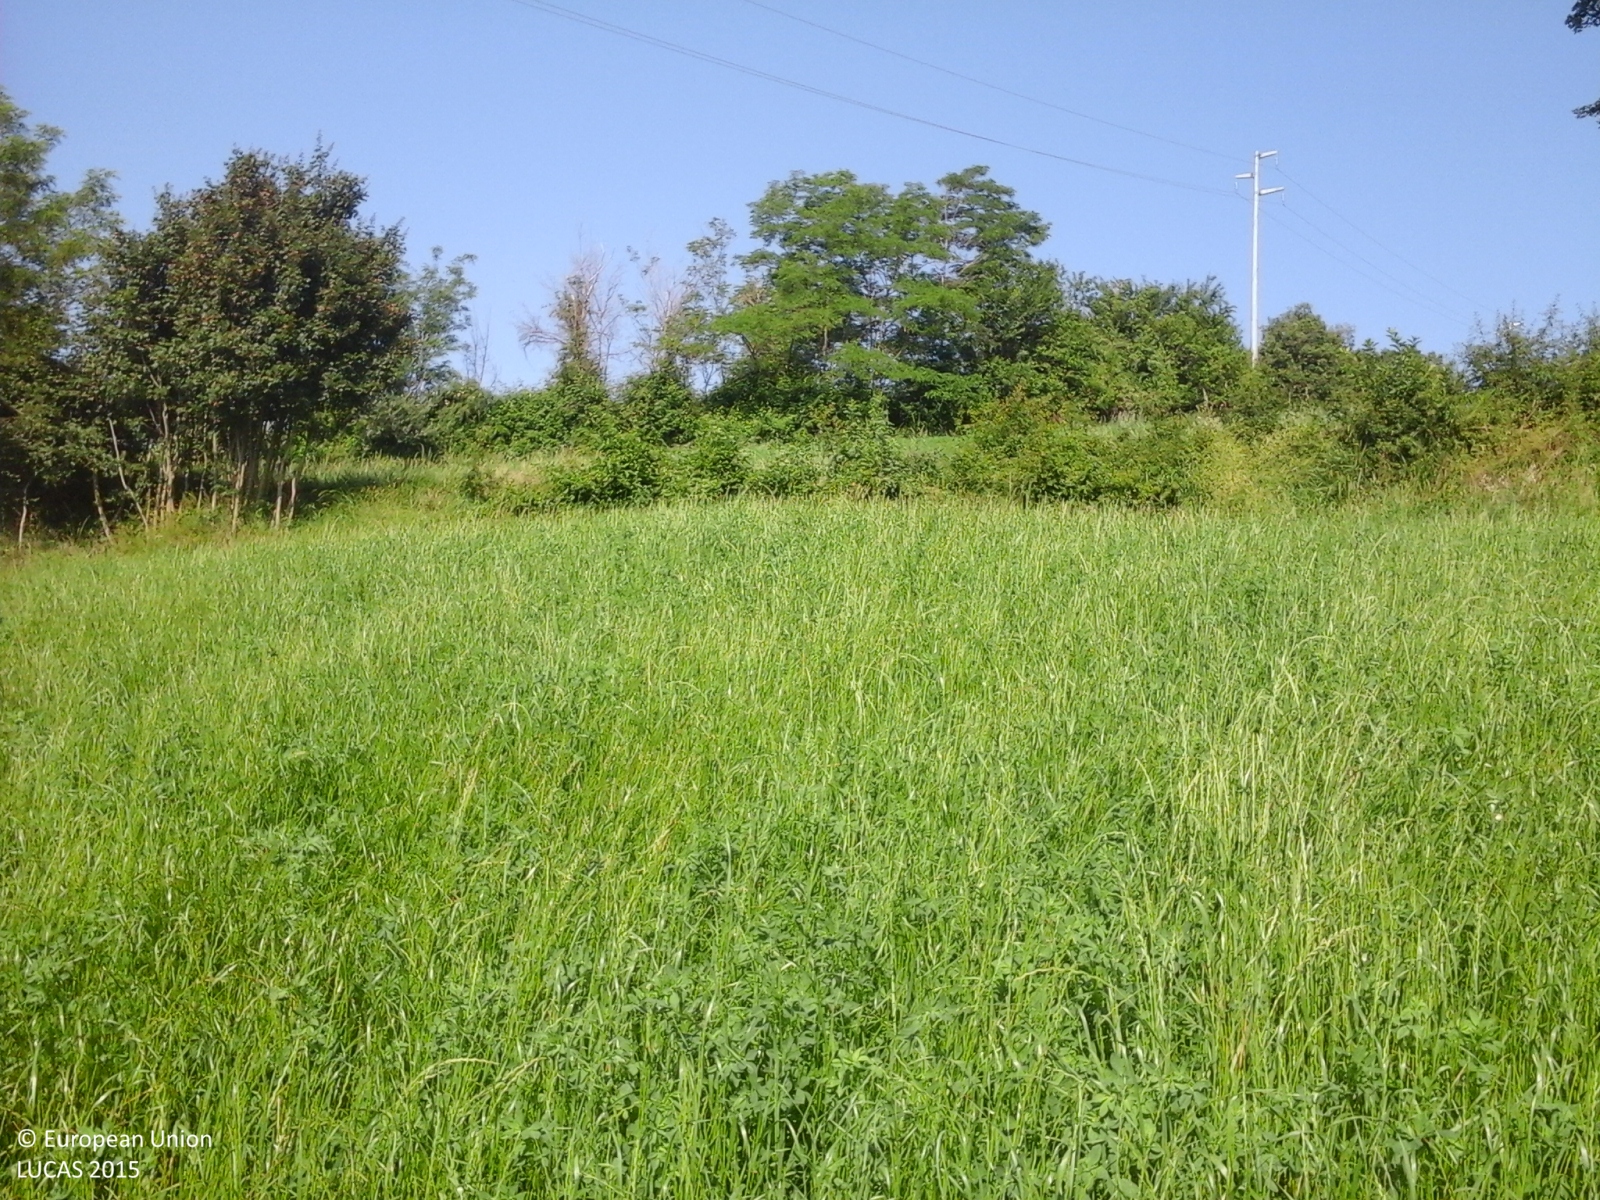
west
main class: Cropland
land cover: Lucerne
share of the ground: > 75 %
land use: Agriculture (excluding fallow land and kitchen gardens)
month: June
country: IT
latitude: 44.4209
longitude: 10.6140
